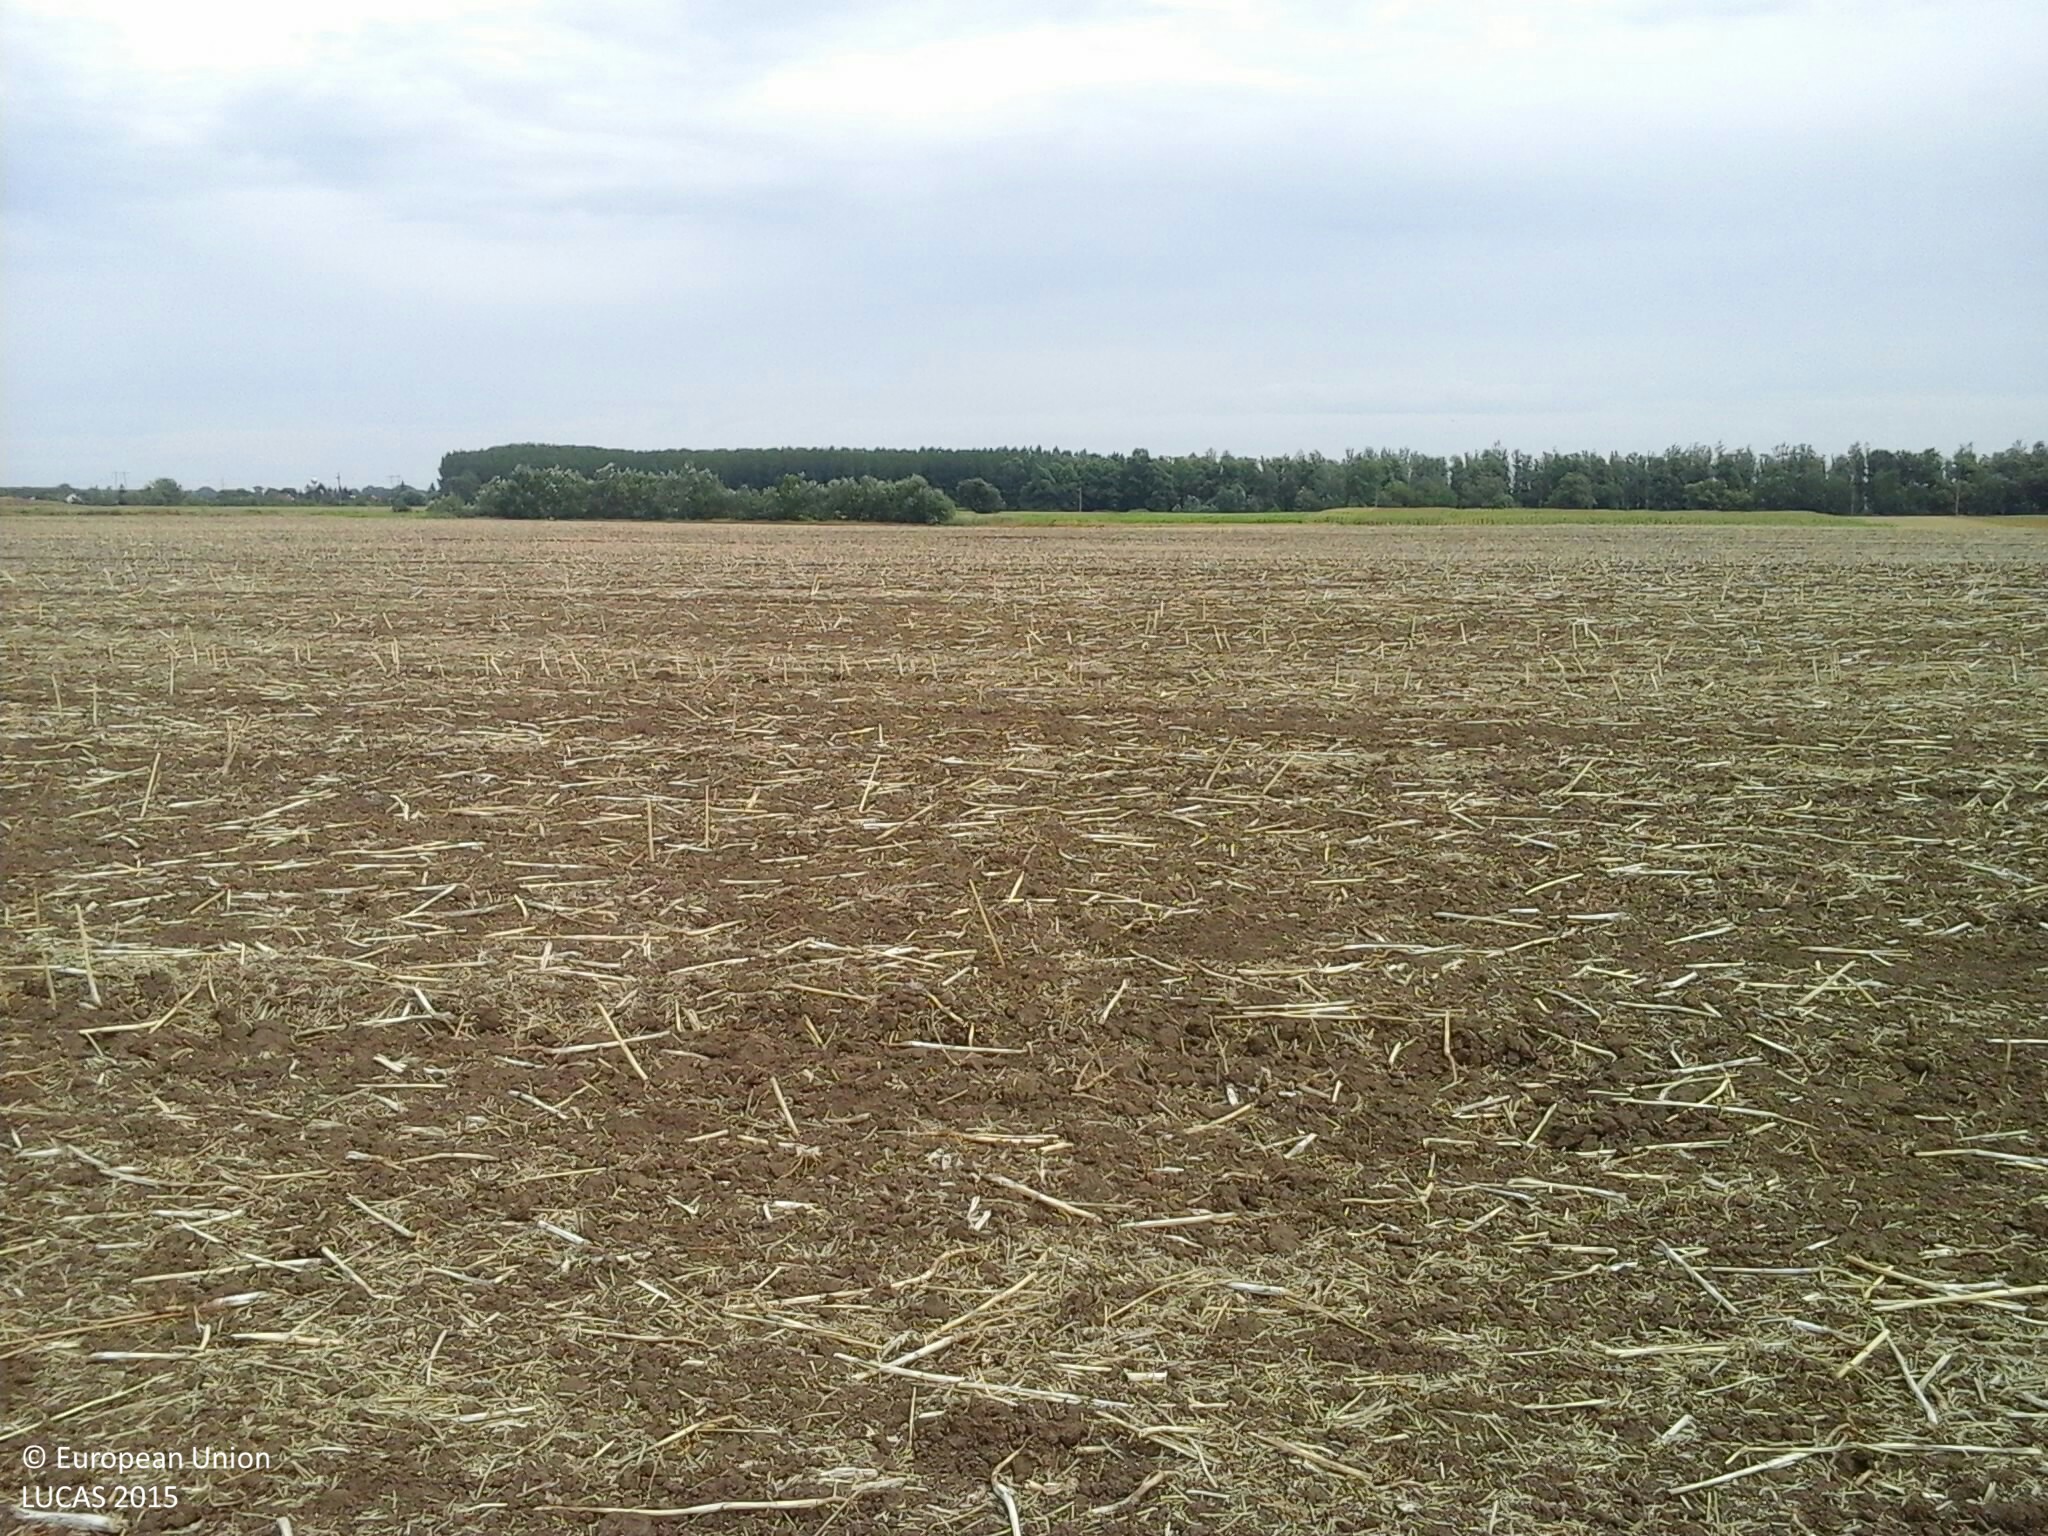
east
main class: Cropland
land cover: Rape and turnip rape
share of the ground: 25 - 50 %
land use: Agriculture (excluding fallow land and kitchen gardens)
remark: Harvested field
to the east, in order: Rape and turnip rape
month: July
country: HU
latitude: 47.8696
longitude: 21.0144
